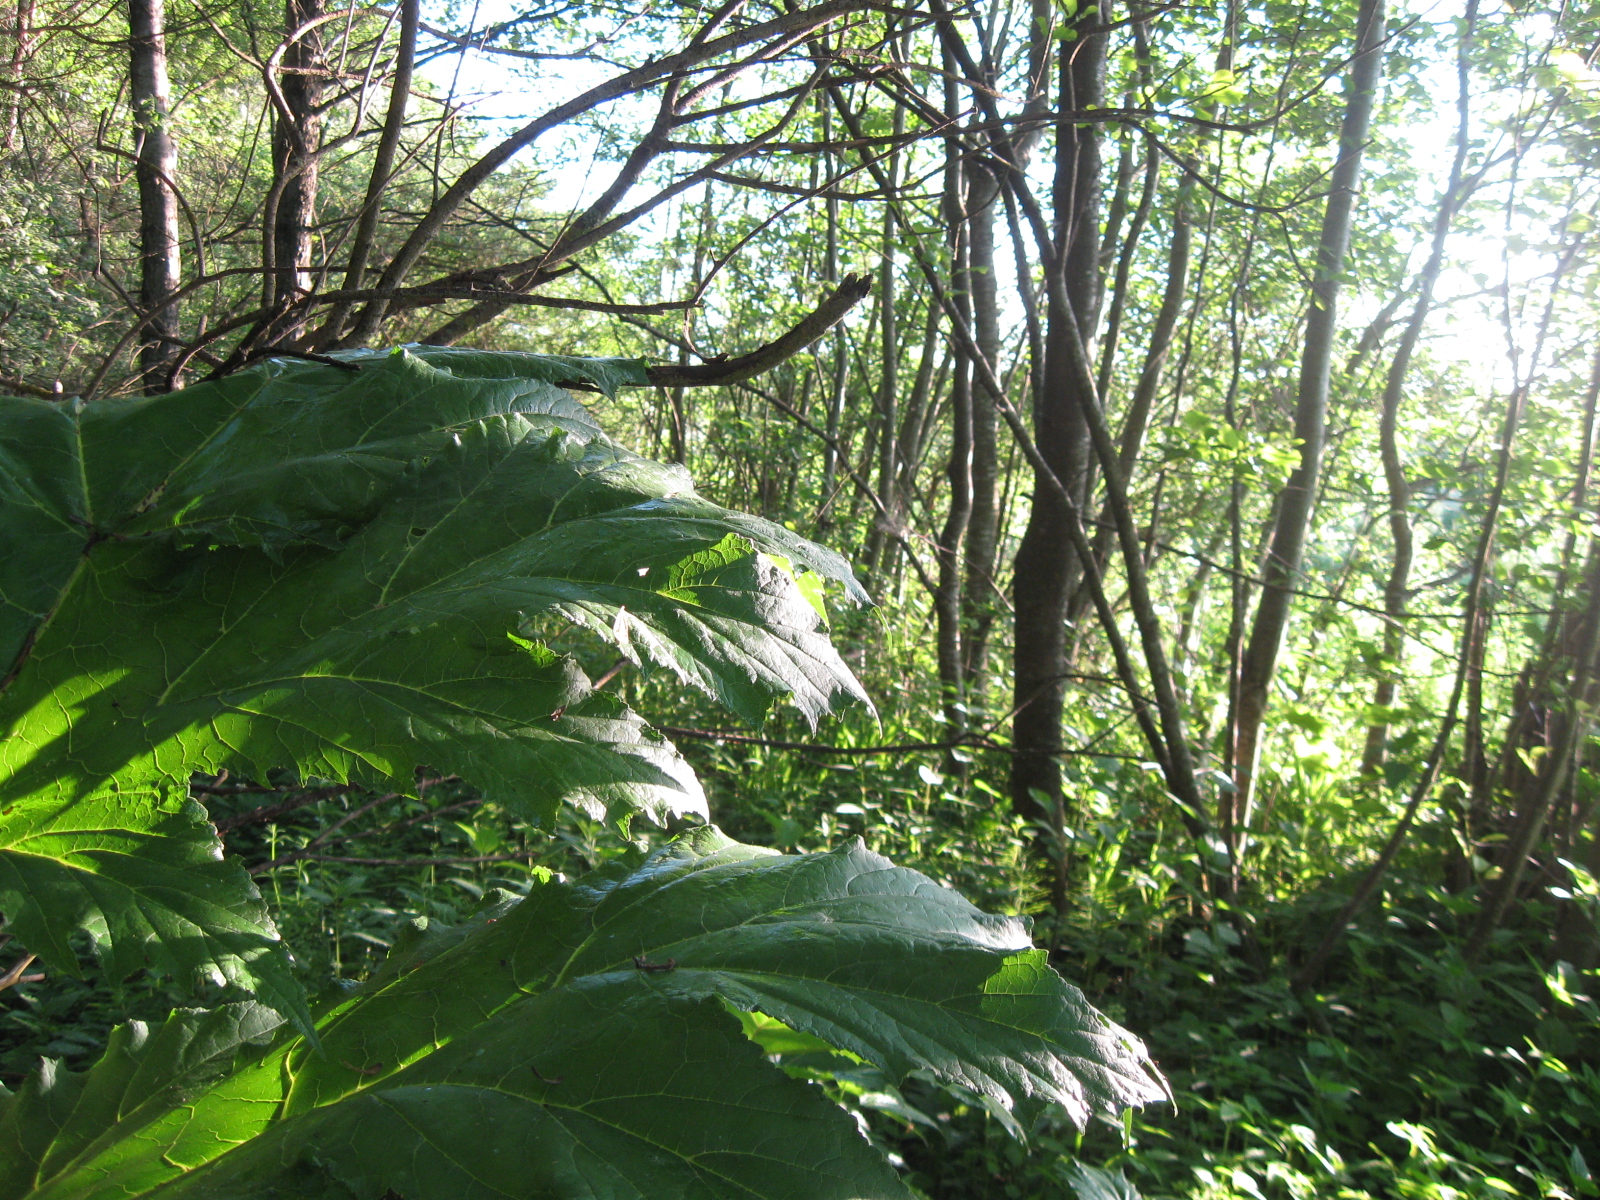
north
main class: Woodland
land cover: Broadleaved woodland
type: non-riverine alder, birch or aspen forest
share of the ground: > 75 %
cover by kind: broadleaved forest trees 90 %, herbaceous plants 10 %
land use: Forestry
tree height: > 5 m
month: June
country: LT
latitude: 55.0664
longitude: 24.0116
